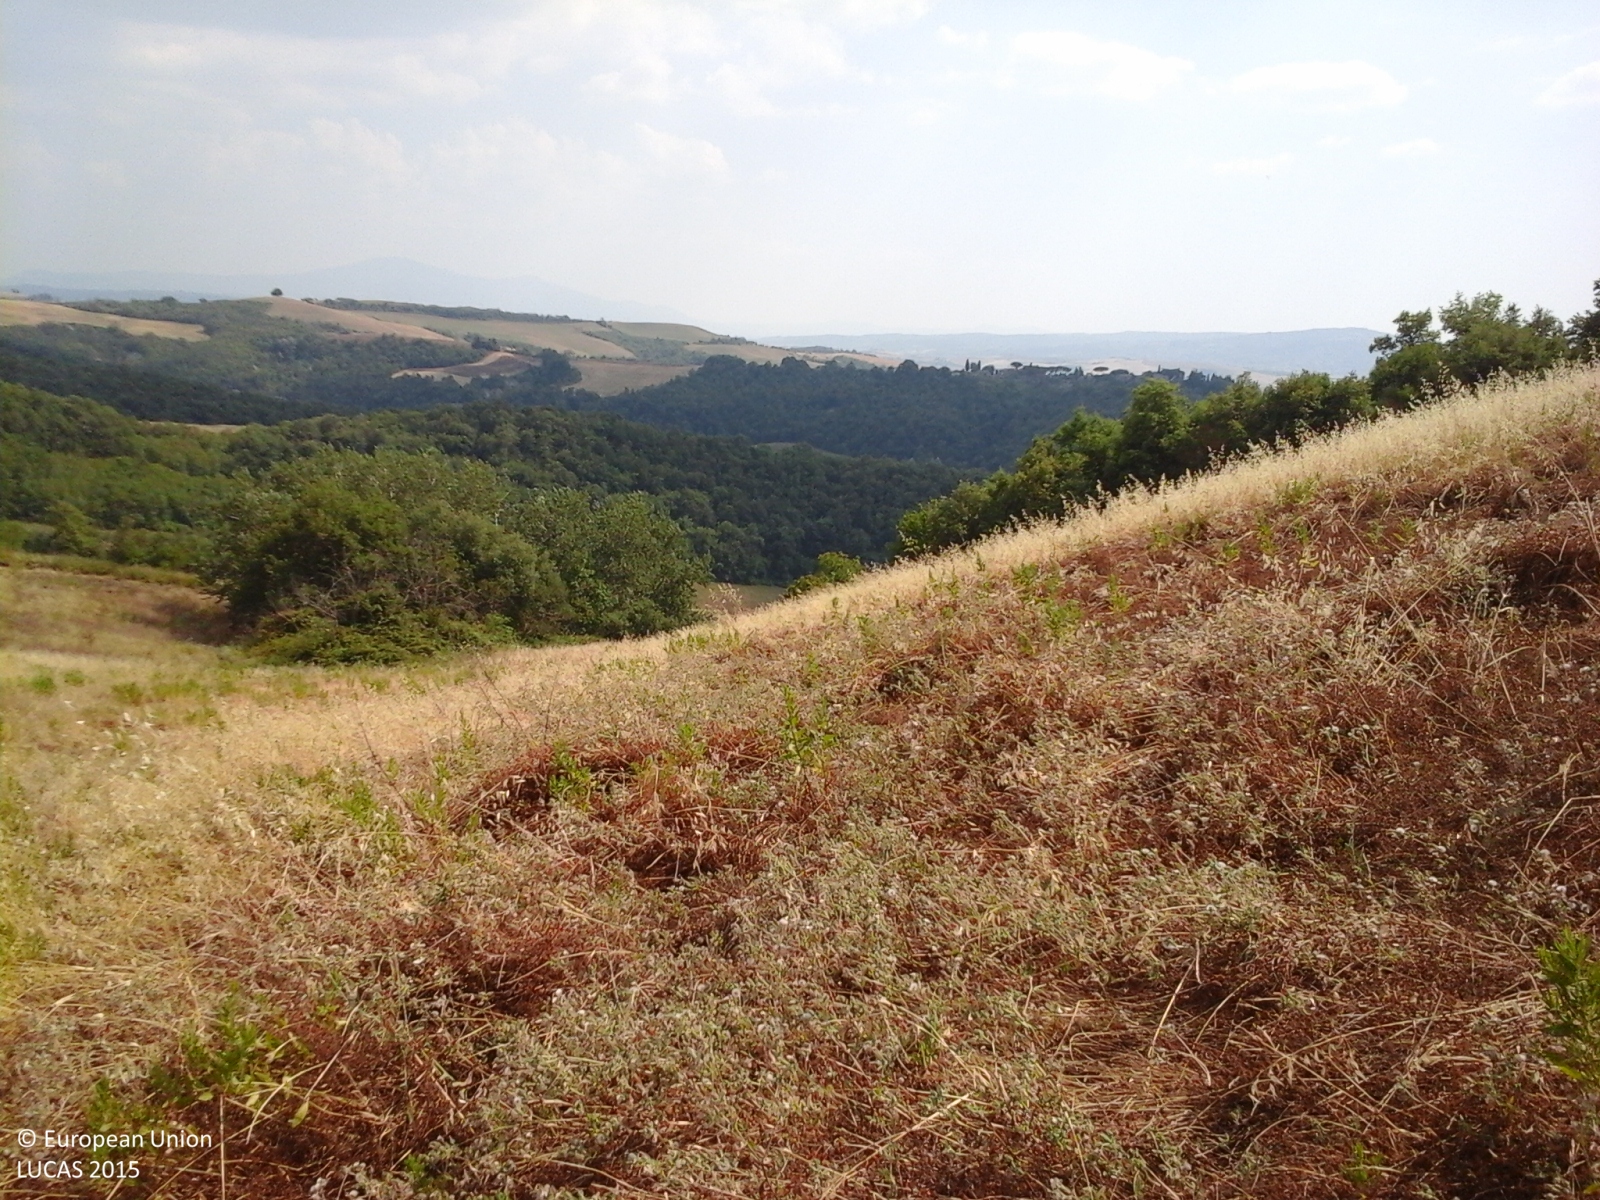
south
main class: Cropland
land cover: Temporary grasslands
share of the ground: > 75 %
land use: Agriculture (excluding fallow land and kitchen gardens)
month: July
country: IT
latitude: 43.1481
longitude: 11.5325
